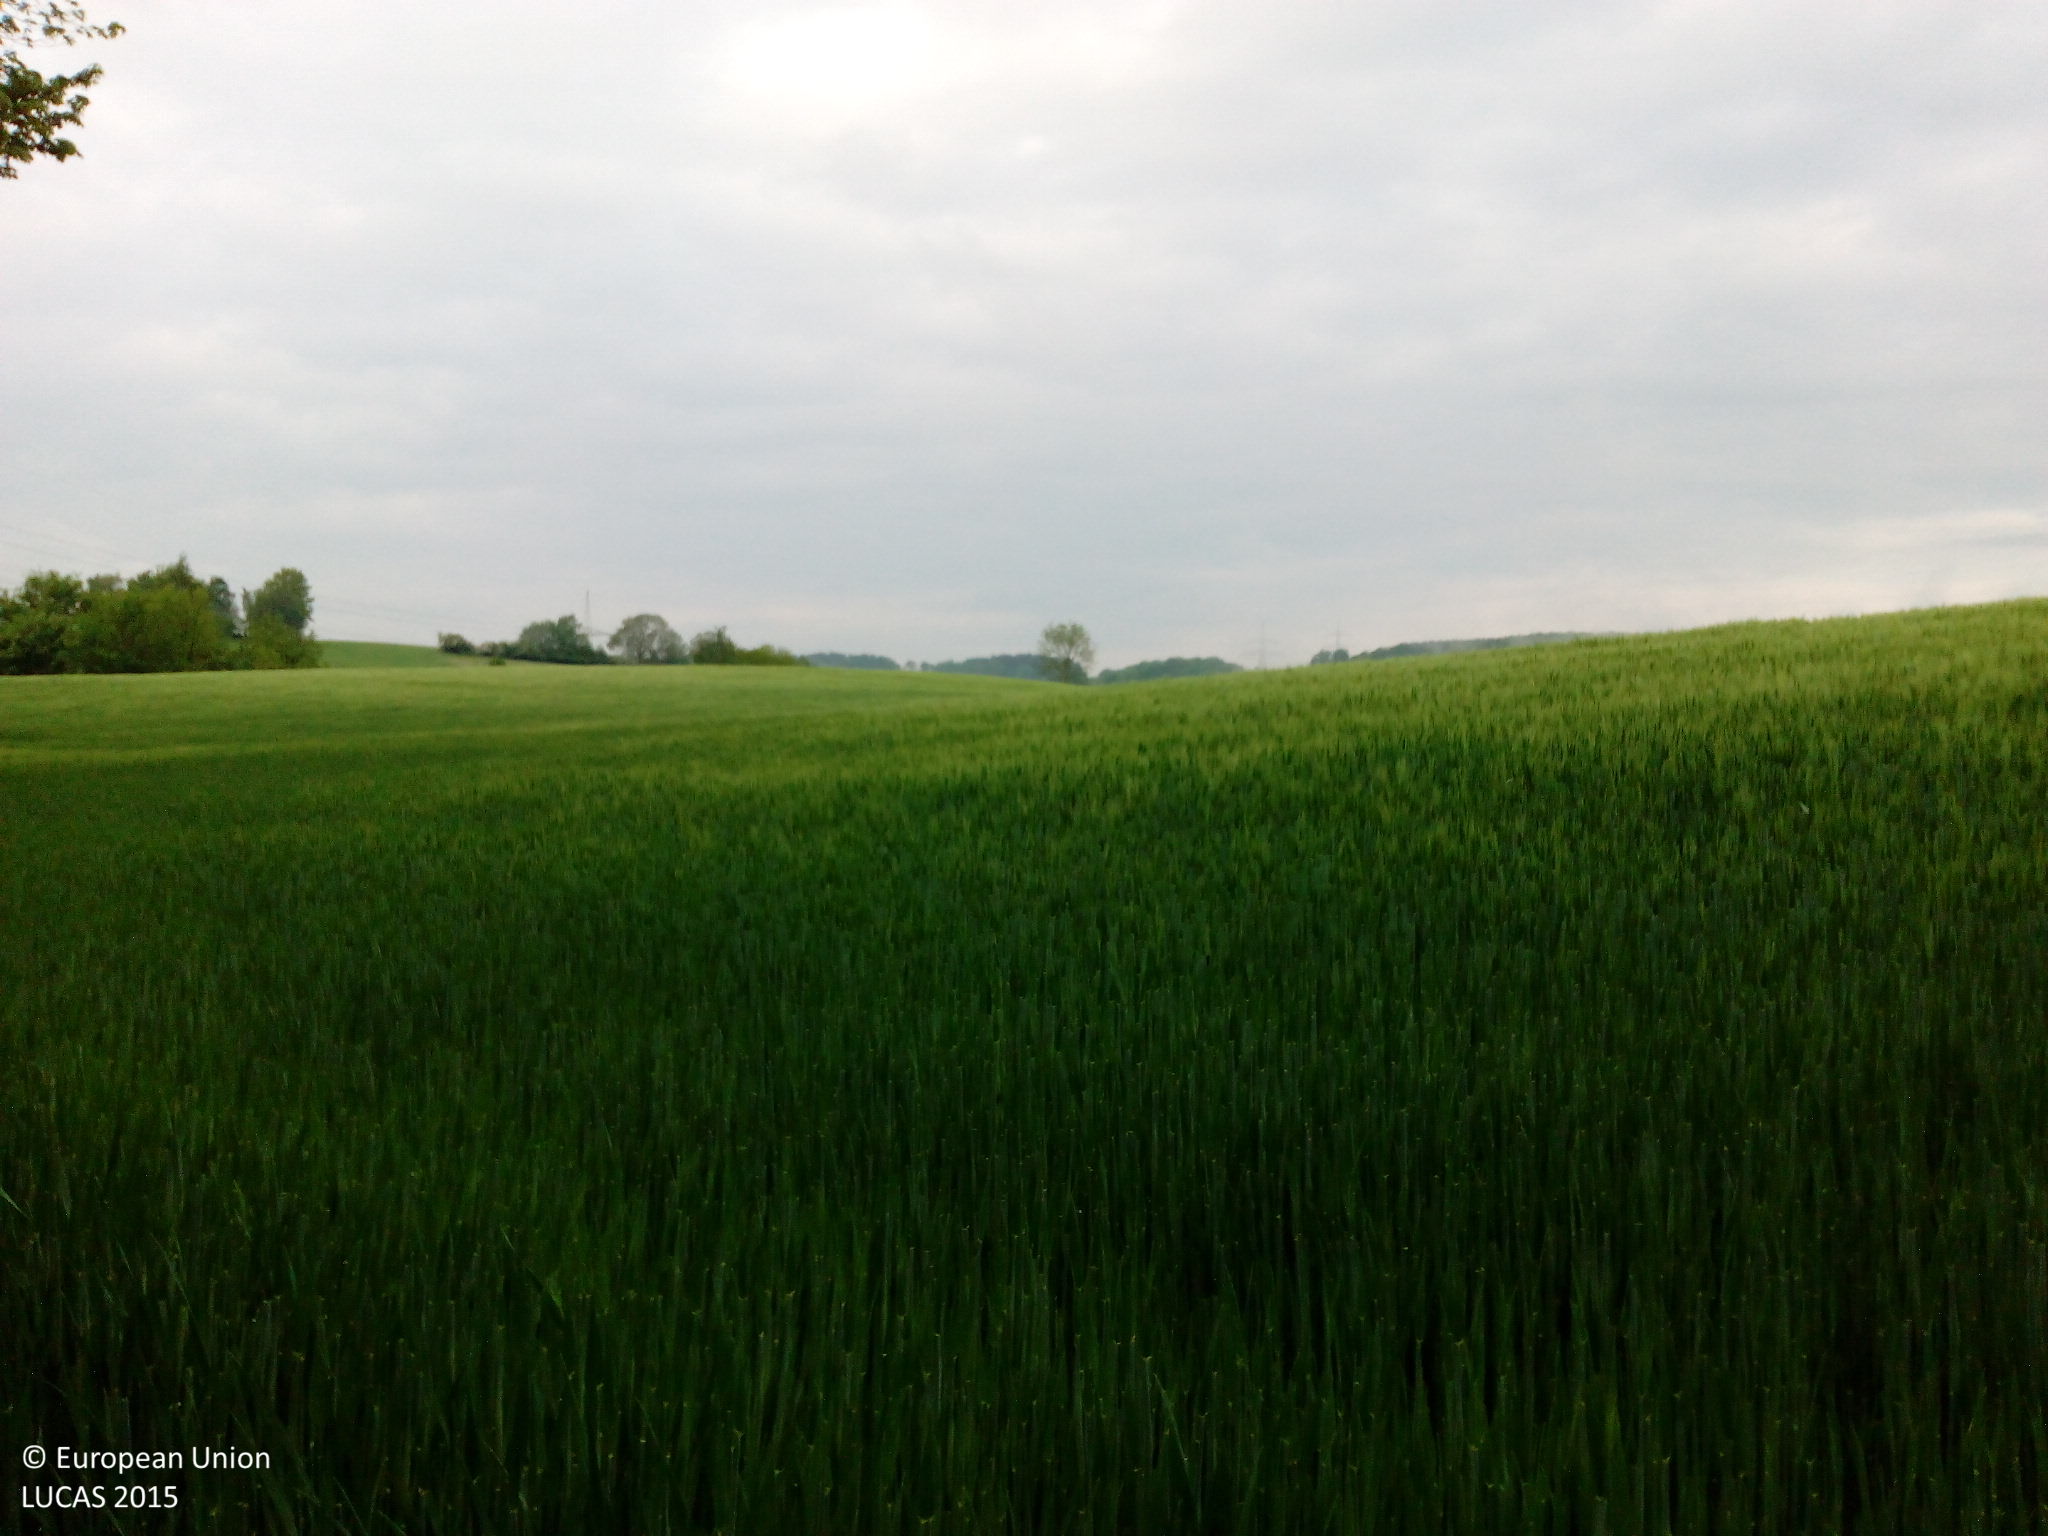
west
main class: Cropland
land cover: Barley
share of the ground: > 75 %
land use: Agriculture (excluding fallow land and kitchen gardens)
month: May
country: DE
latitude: 50.6109
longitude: 13.0666
